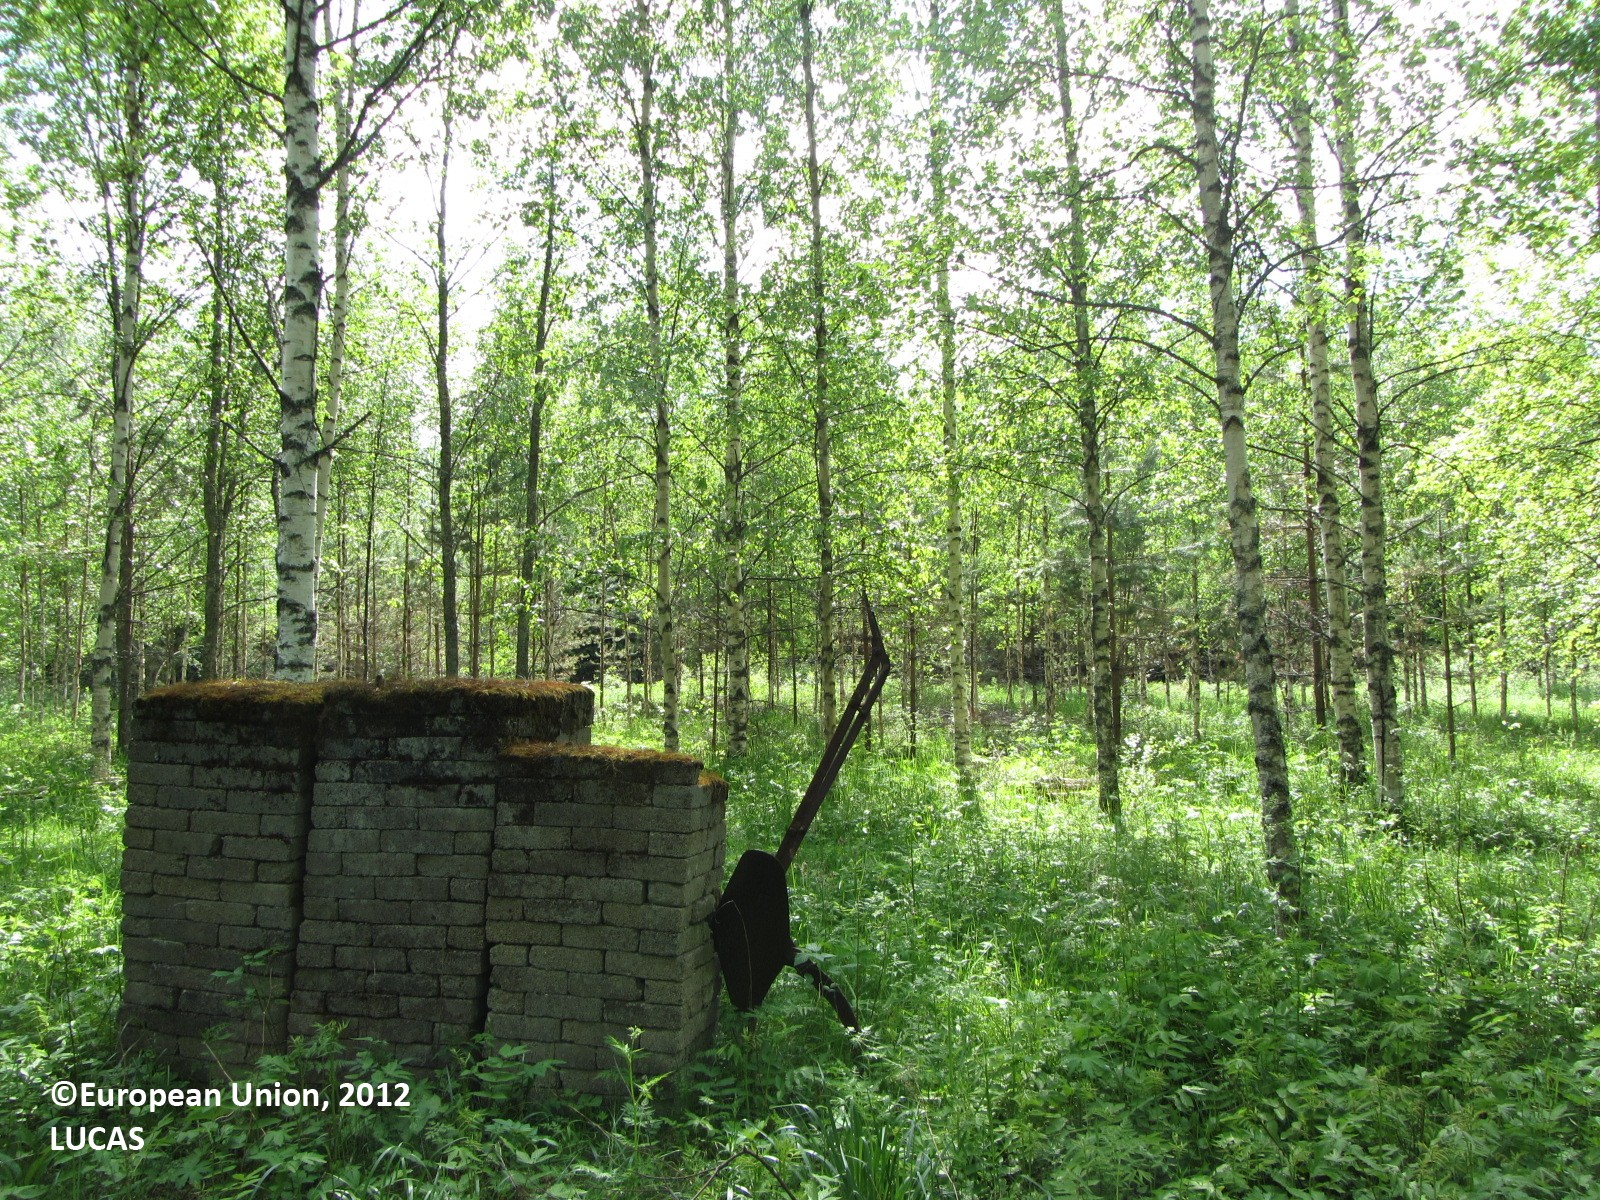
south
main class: Woodland
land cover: Broadleaved woodland
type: hemiboreal forest and nemoral coniferous forest and mixed broadleaved-coniferous forest
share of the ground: 50 - 75 %
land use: Forestry
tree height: > 5 m
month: June
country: FI
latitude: 61.9613
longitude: 25.0376
